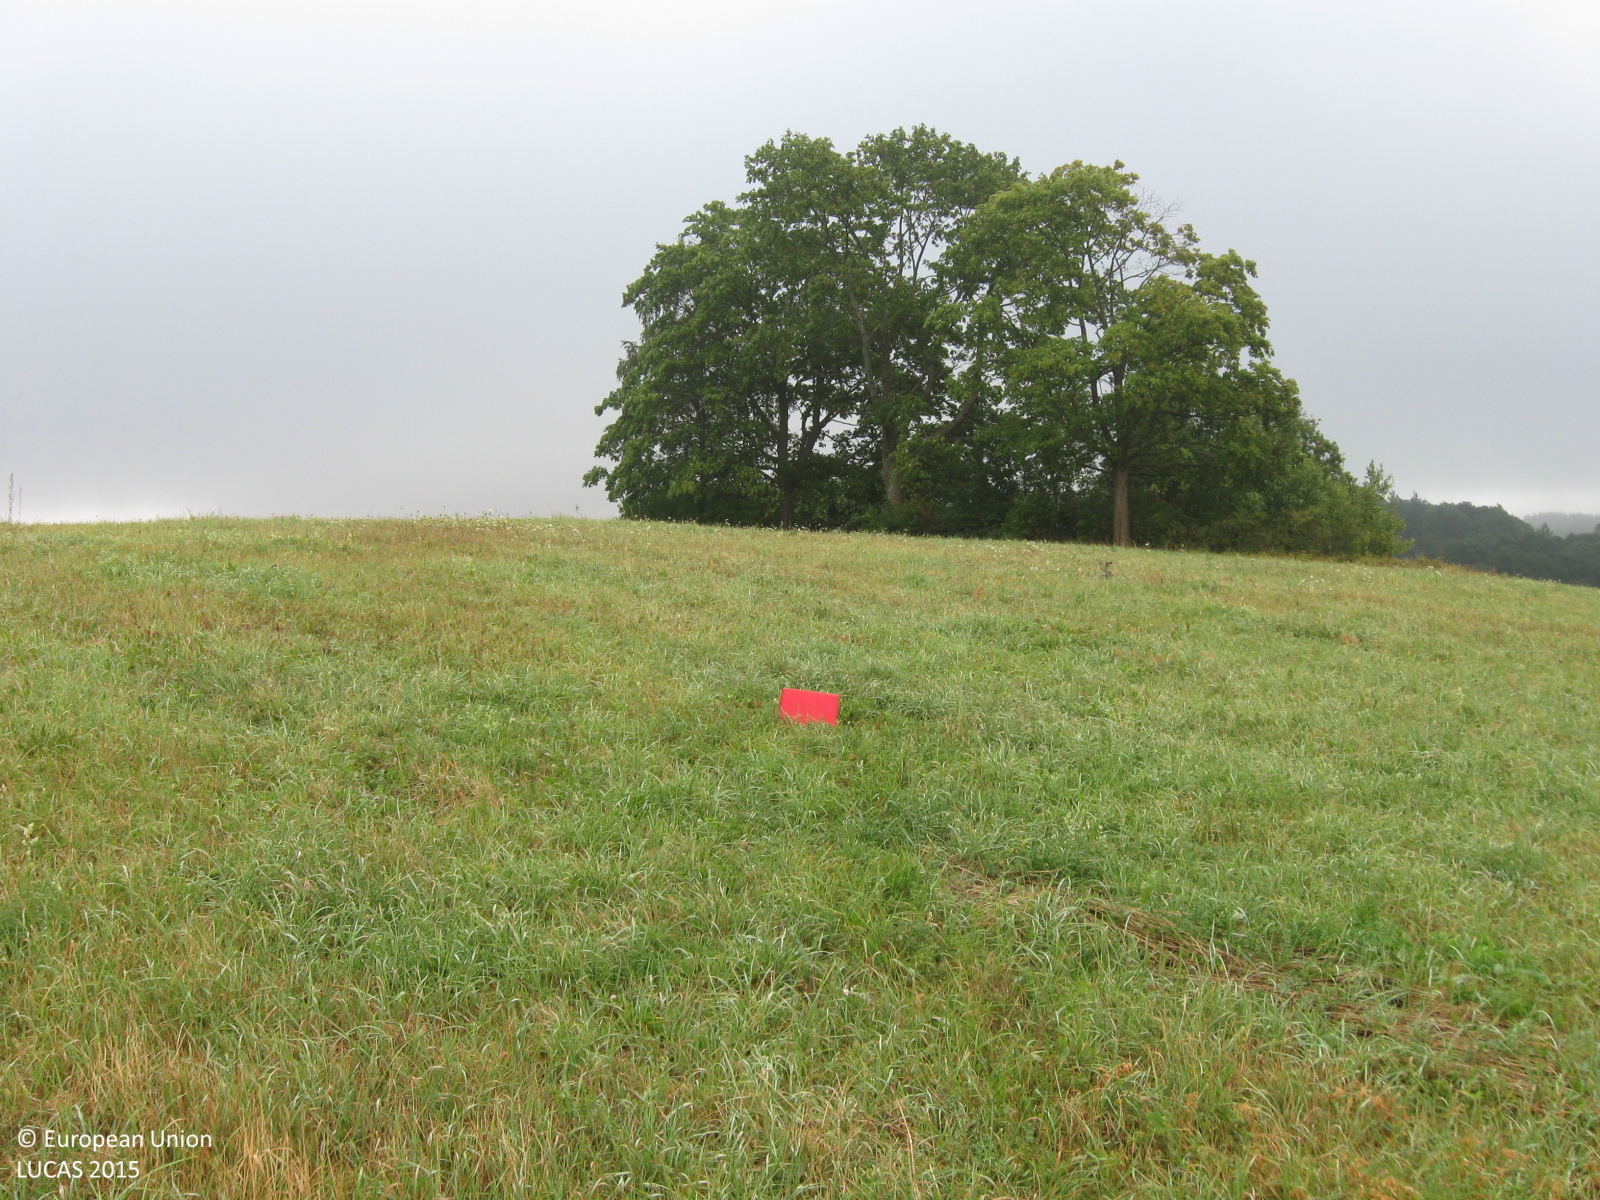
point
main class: Grassland
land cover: Grassland without tree/shrub cover
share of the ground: > 75 %
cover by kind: herbaceous plants 100 %
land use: Agriculture (excluding fallow land and kitchen gardens)
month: August
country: LT
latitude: 55.3402
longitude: 23.1757
